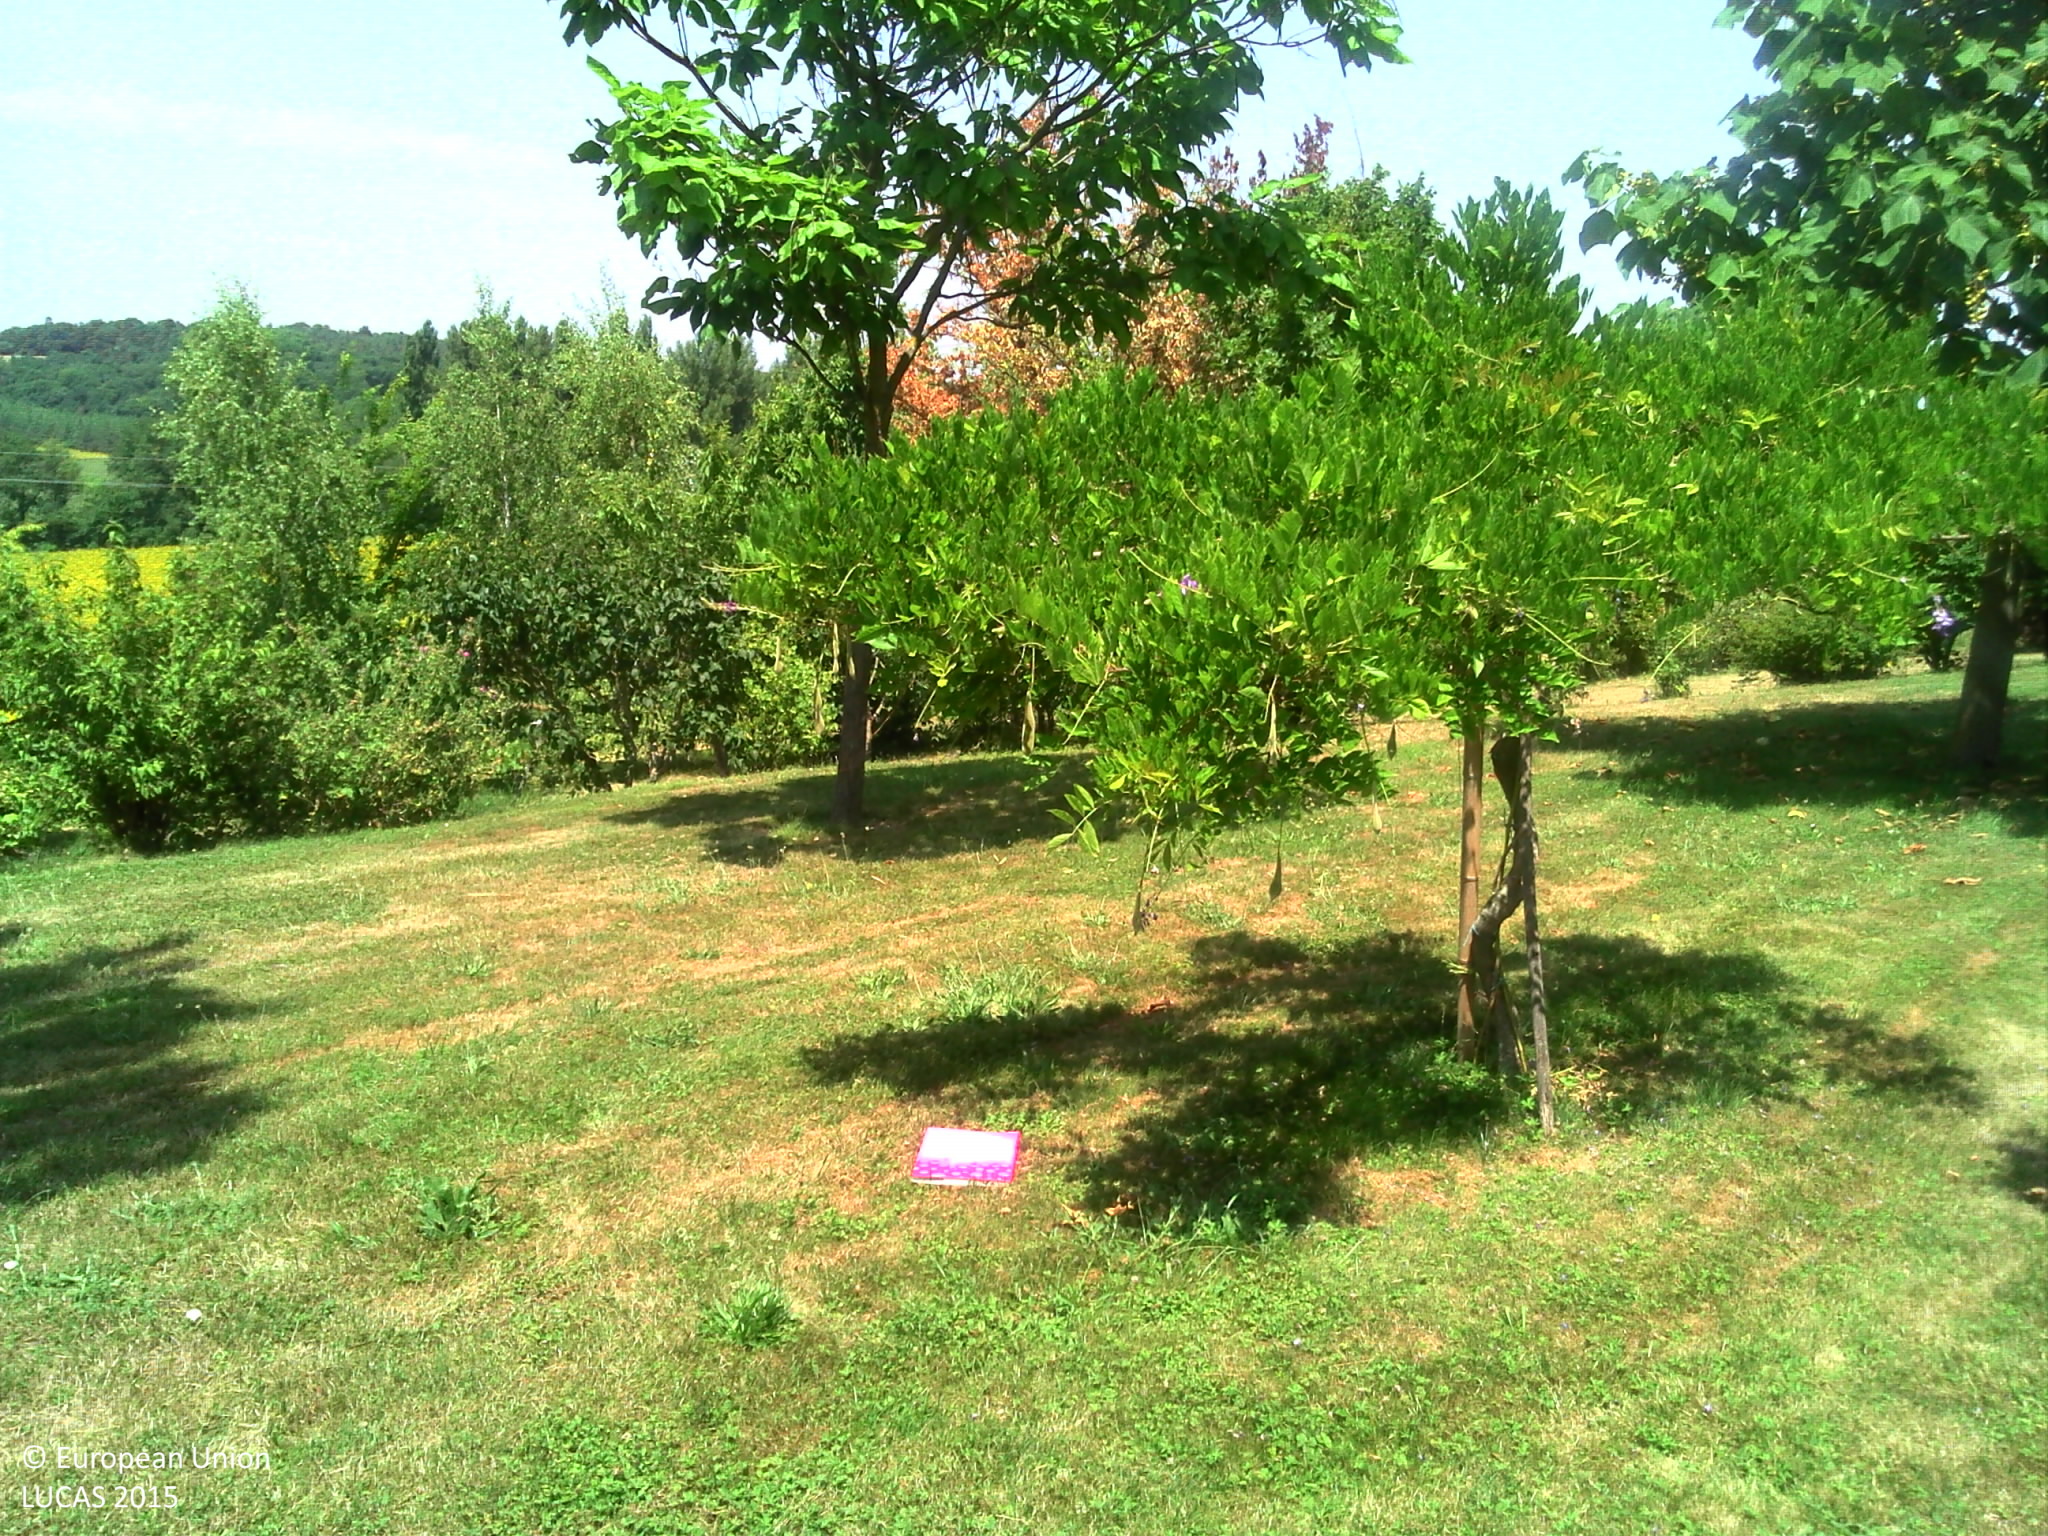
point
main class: Grassland
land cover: Grassland with sparse tree/shrub cover
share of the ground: > 75 %
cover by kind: herbaceous plants 85 %, shrubs 10 %, broadleaved forest trees 5 %
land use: Residential
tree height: < 5 m
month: July
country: FR
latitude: 43.4838
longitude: 0.9626
